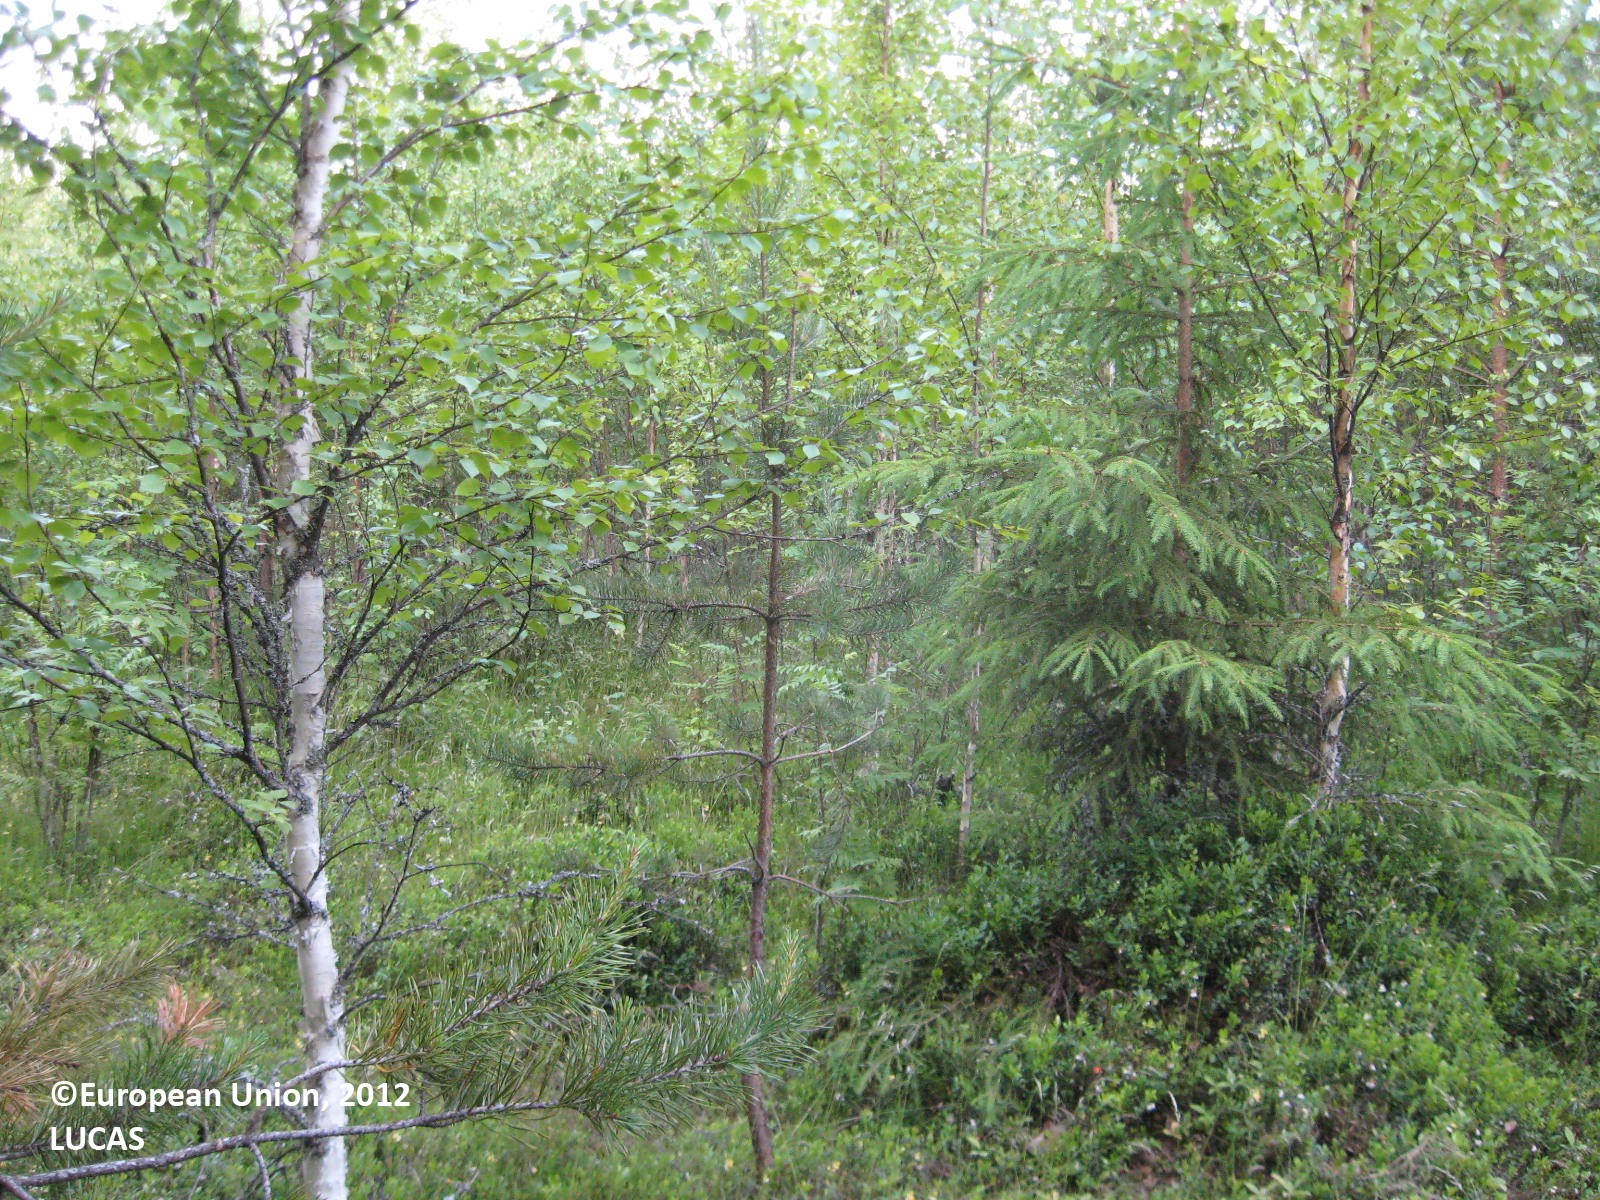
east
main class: Woodland
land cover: Pine dominated mixed woodland
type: boreal forest
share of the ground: > 75 %
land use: Forestry
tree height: > 5 m
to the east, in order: Pine dominated mixed woodland; Other mixed woodland
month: July
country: FI
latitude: 62.5885
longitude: 22.6544
